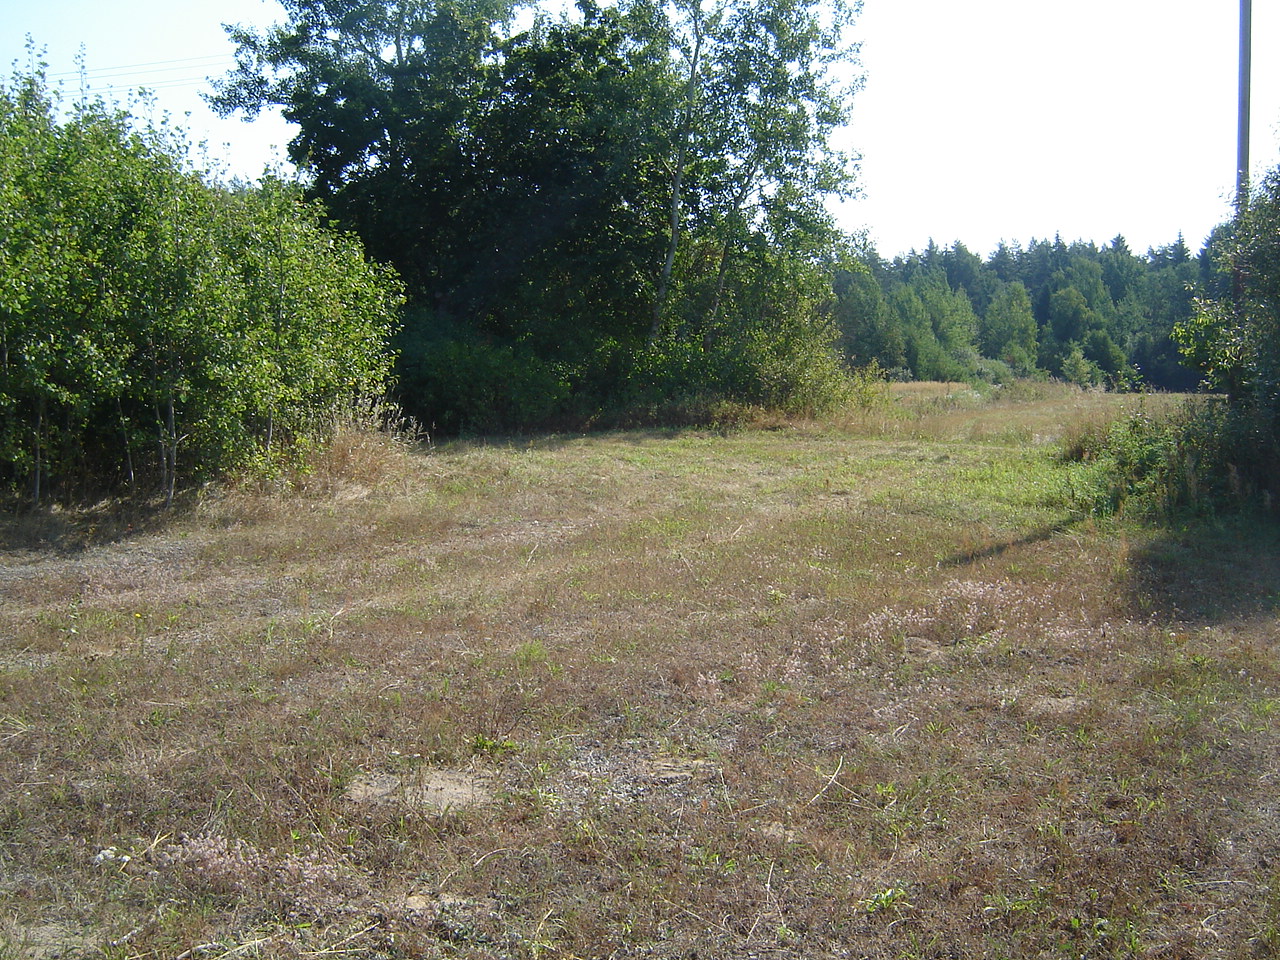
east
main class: Grassland
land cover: Grassland without tree/shrub cover
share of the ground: > 75 %
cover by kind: herbaceous plants 100 %
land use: Agriculture (excluding fallow land and kitchen gardens)
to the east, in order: Grassland without tree/shrub cover; Broadleaved woodland; Electric lines; Tracks; Broadleaved woodland; Grass margins; Oats; Rye; Broadleaved woodland; Pine dominated mixed woodland; Tracks; Pine dominated mixed woodland
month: August
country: LT
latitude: 54.6147
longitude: 24.9001
